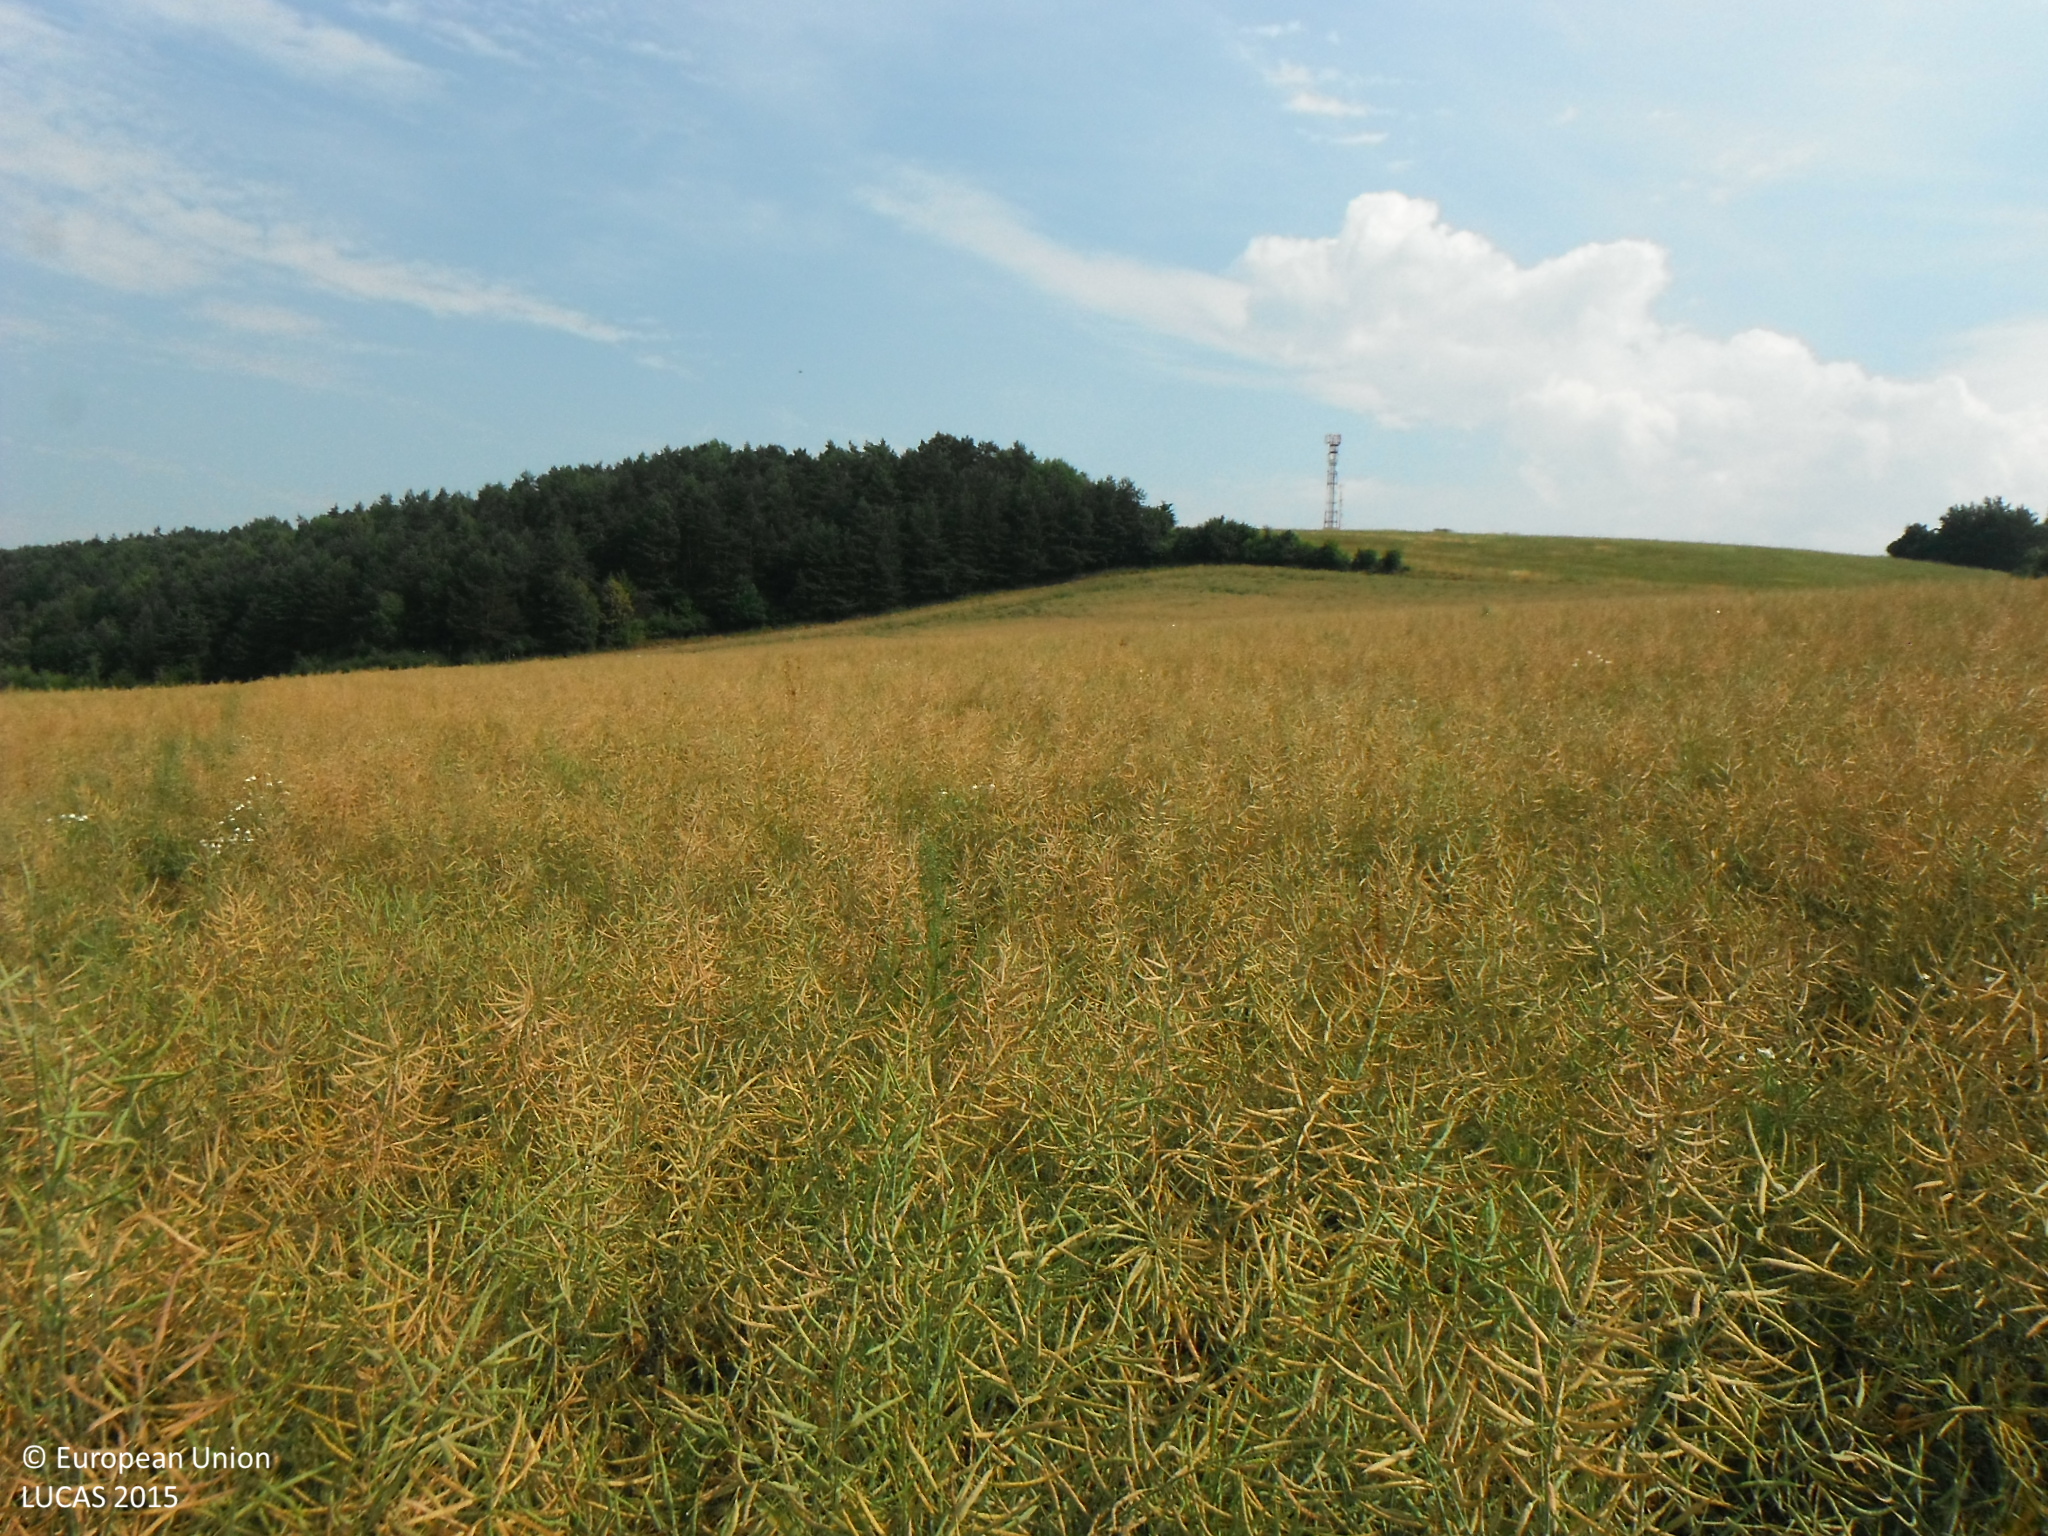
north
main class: Cropland
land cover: Rape and turnip rape
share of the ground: > 75 %
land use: Agriculture (excluding fallow land and kitchen gardens)
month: July
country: SK
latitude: 49.1725
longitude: 21.4186
